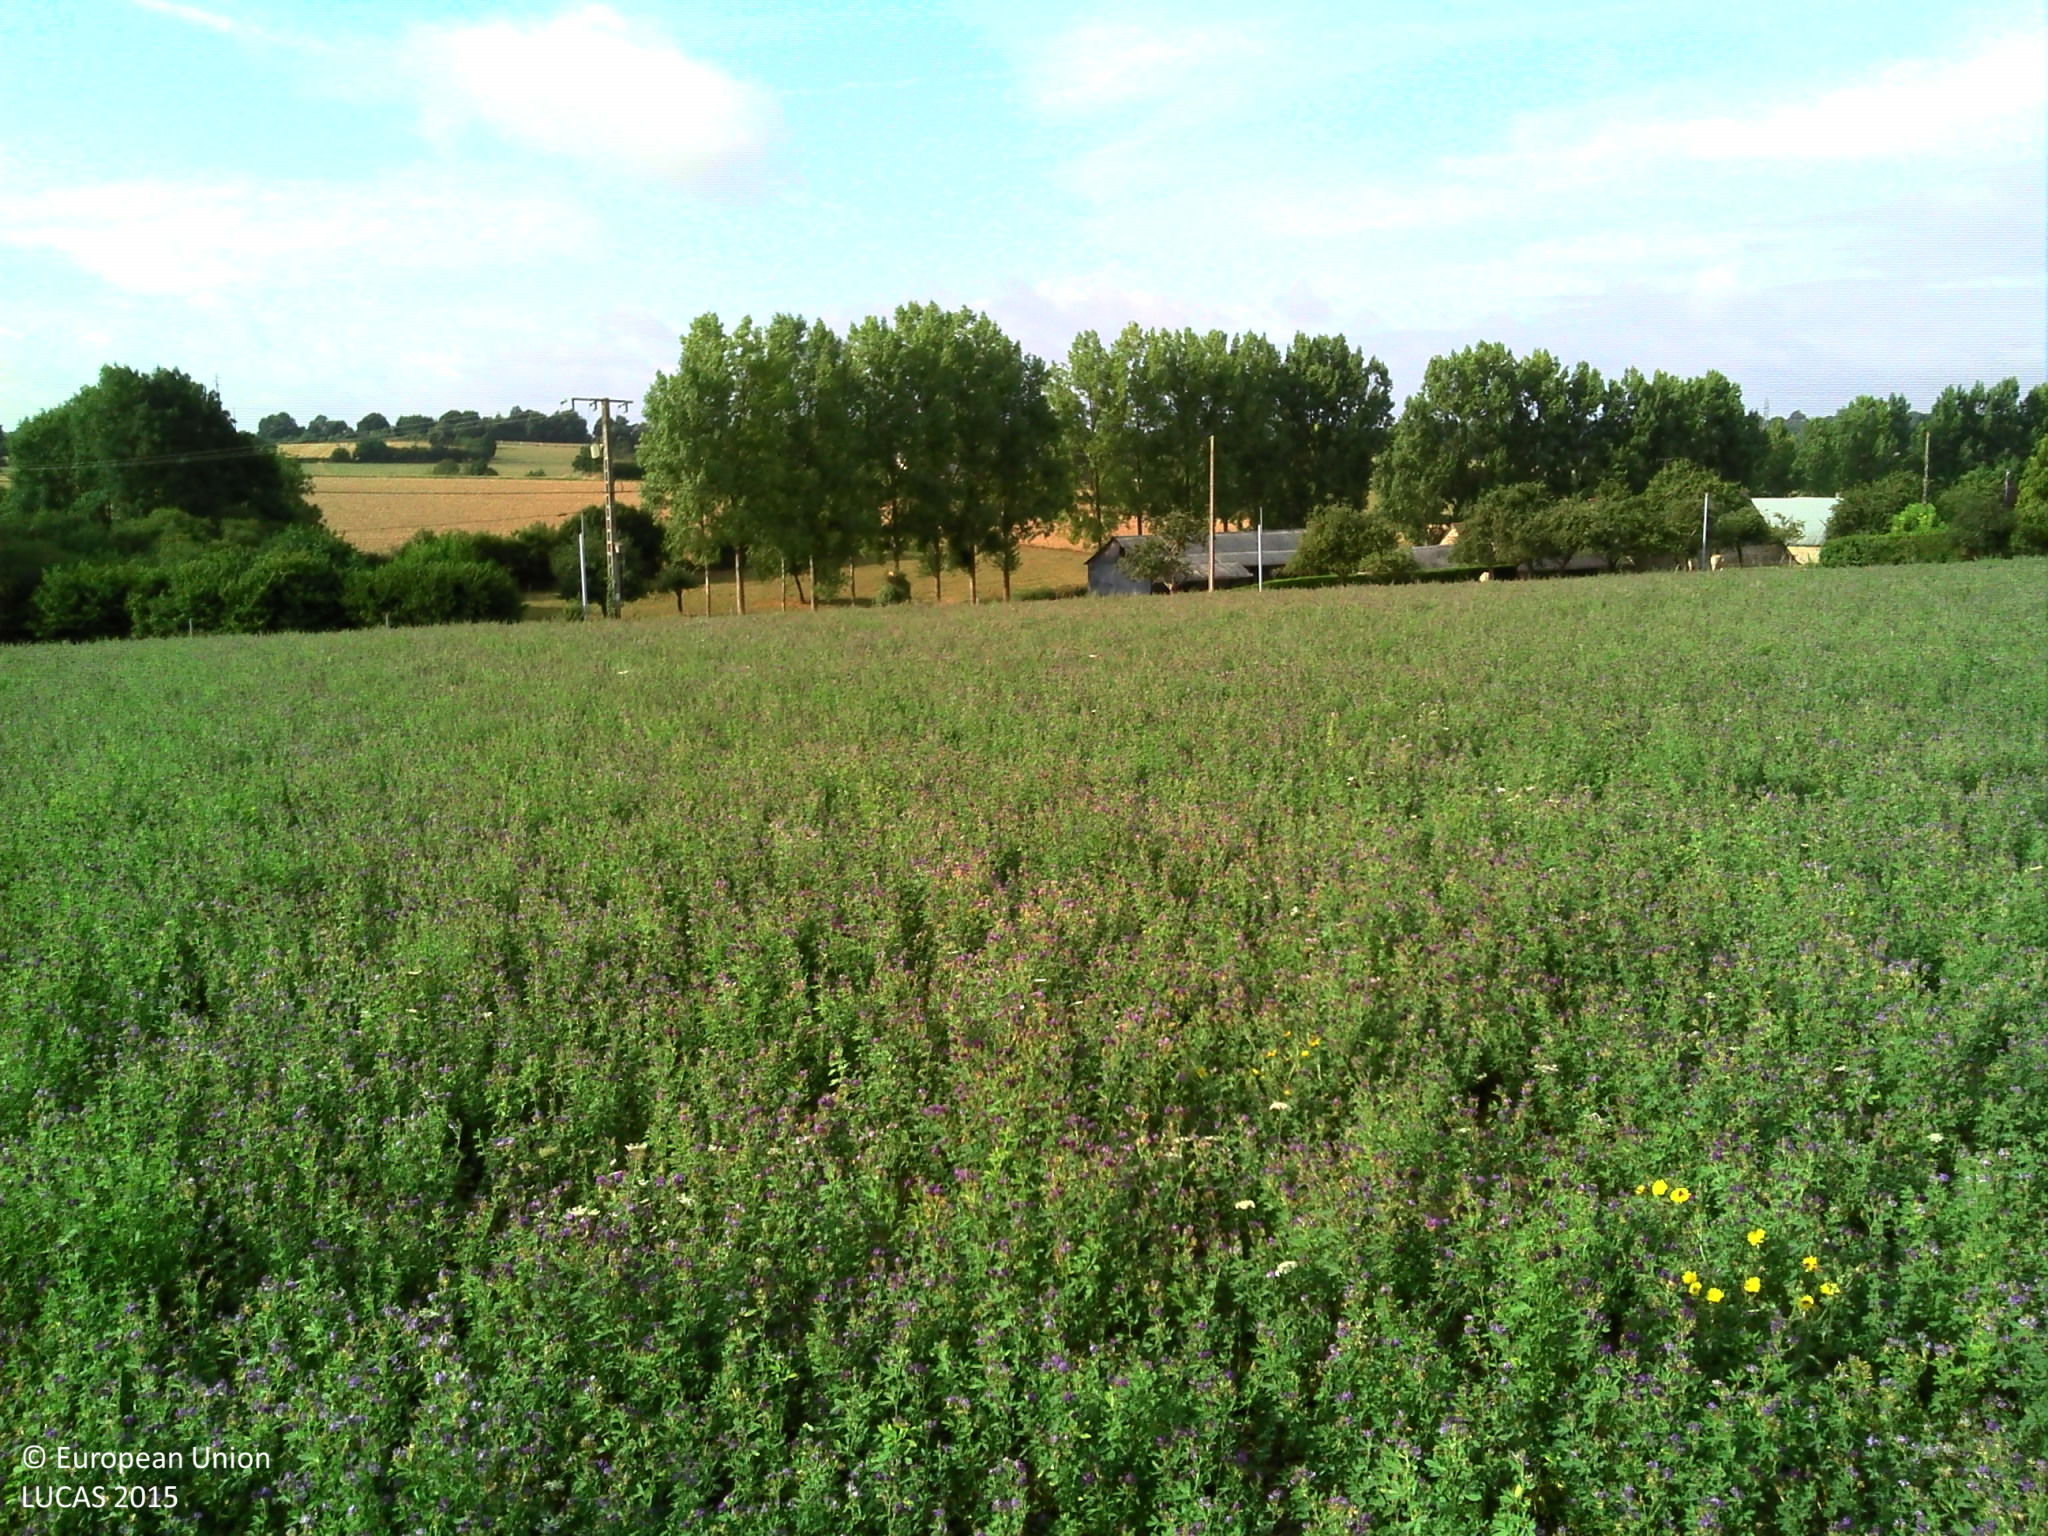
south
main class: Cropland
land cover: Lucerne
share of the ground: > 75 %
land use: Agriculture (excluding fallow land and kitchen gardens)
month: August
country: FR
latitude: 47.7755
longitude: -1.3994
